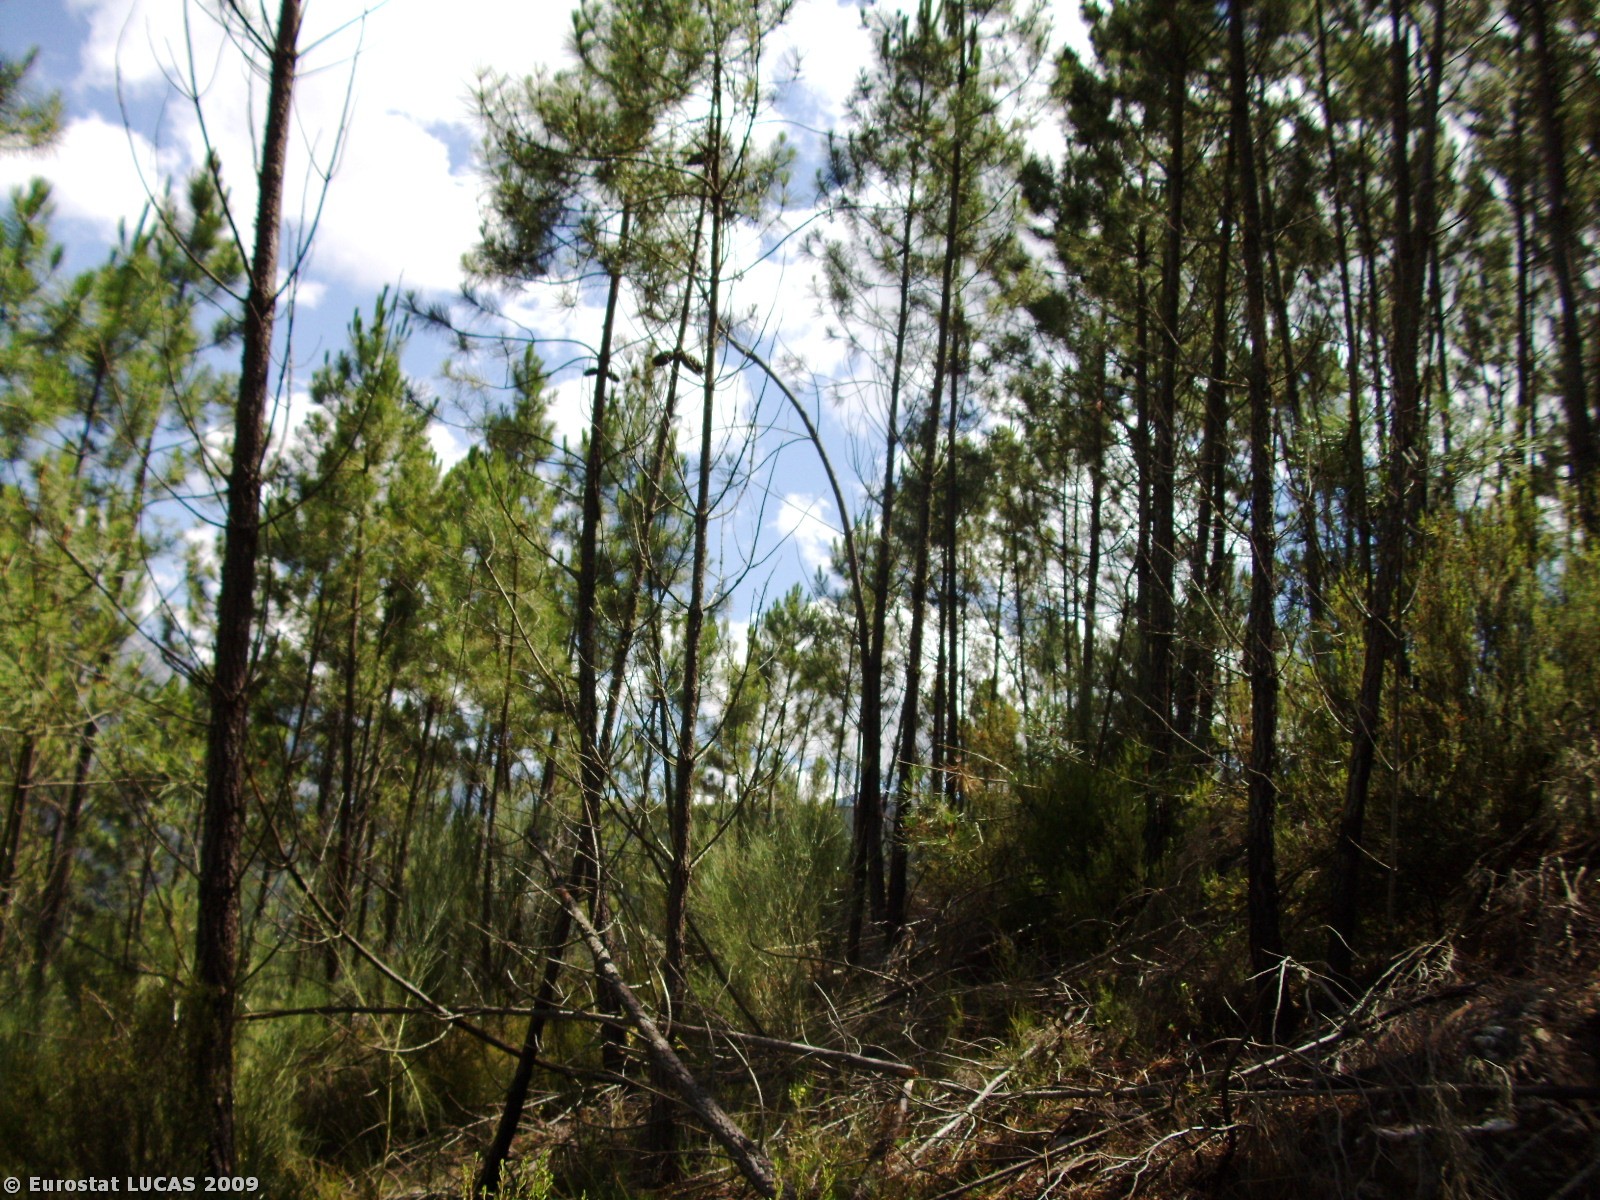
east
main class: Woodland
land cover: Coniferous woodland
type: coniferous forest of the mediterranean region
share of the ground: > 75 %
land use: Forestry
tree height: > 5 m
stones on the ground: 25 - 50 %
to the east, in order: Coniferous woodland
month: June
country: PT
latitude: 40.2832
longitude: -7.7206
